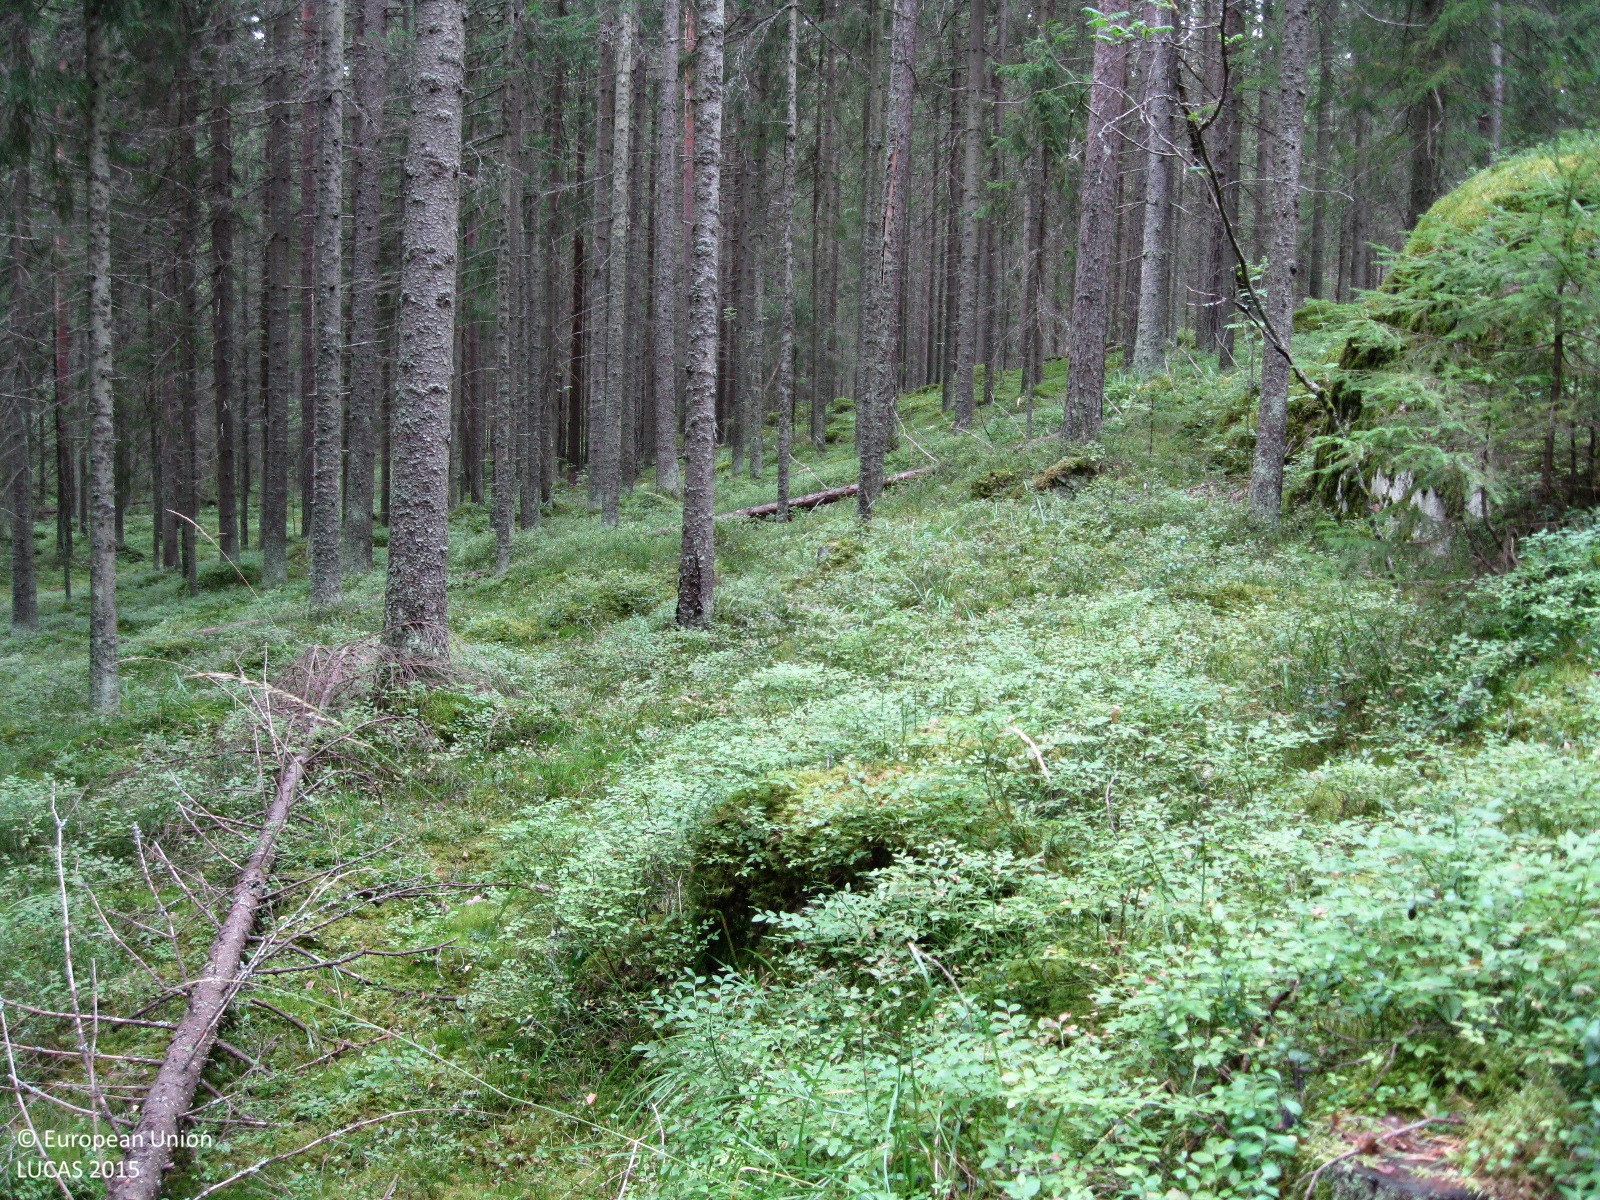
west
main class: Woodland
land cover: Spruce dominated coniferous woodland
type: boreal forest
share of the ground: > 75 %
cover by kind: coniferous forest trees 80 %, shrubs 10 %, broadleaved forest trees 5 %, lichens and mosses 5 %
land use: Forestry
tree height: > 5 m
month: September
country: FI
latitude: 60.6945
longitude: 25.0064
